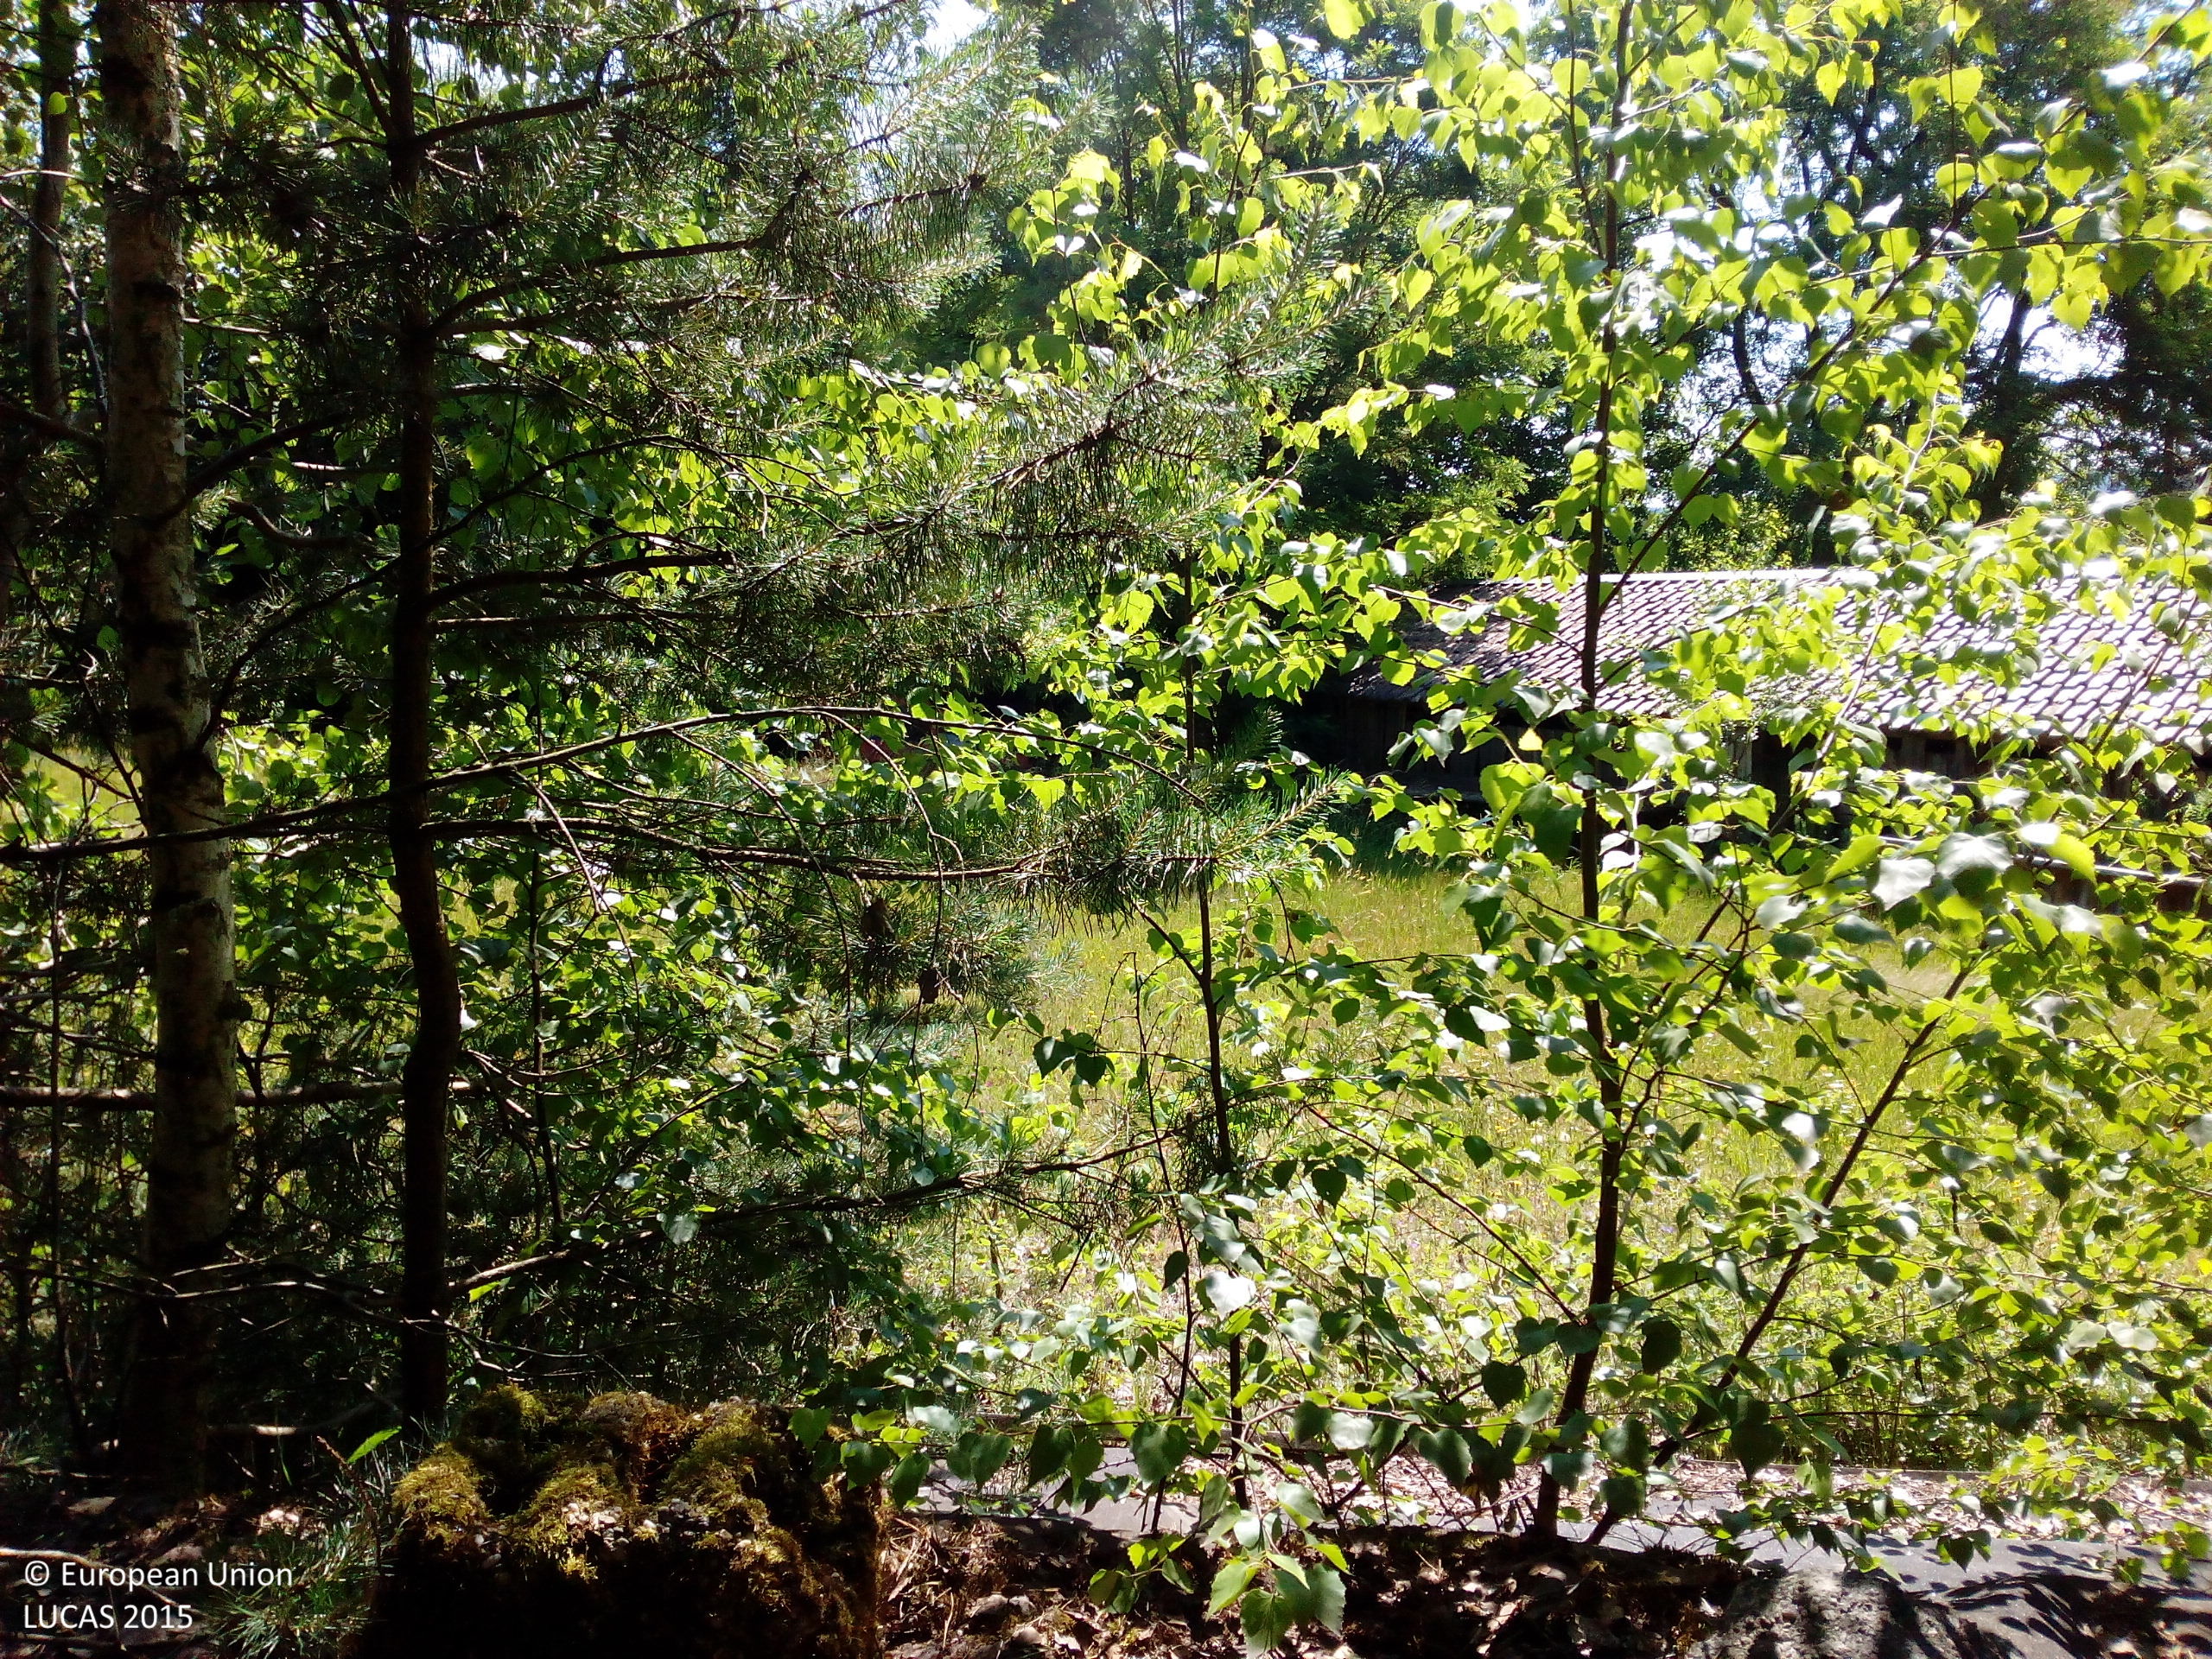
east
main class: Woodland
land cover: Broadleaved woodland
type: mesophytic deciduous forest
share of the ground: > 75 %
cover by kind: broadleaved forest trees 45 %, herbaceous plants 10 %, coniferous forest trees 5 %, lichens and mosses 5 %, unconsolidated bare surface 5 %
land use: Logistics and storage
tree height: > 5 m
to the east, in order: Broadleaved woodland; Grassland without tree/shrub cover; Paved roads, cycling and walking lanes; Grassland without tree/shrub cover; Broadleaved woodland; Grassland without tree/shrub cover; Artificial constructions in urban areas; Grassland without tree/shrub cover; Paved roads, cycling and walking lanes; Broadleaved woodland; Paved roads, cycling and walking lanes; Broadleaved woodland
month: June
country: DE
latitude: 49.1885
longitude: 12.3457
